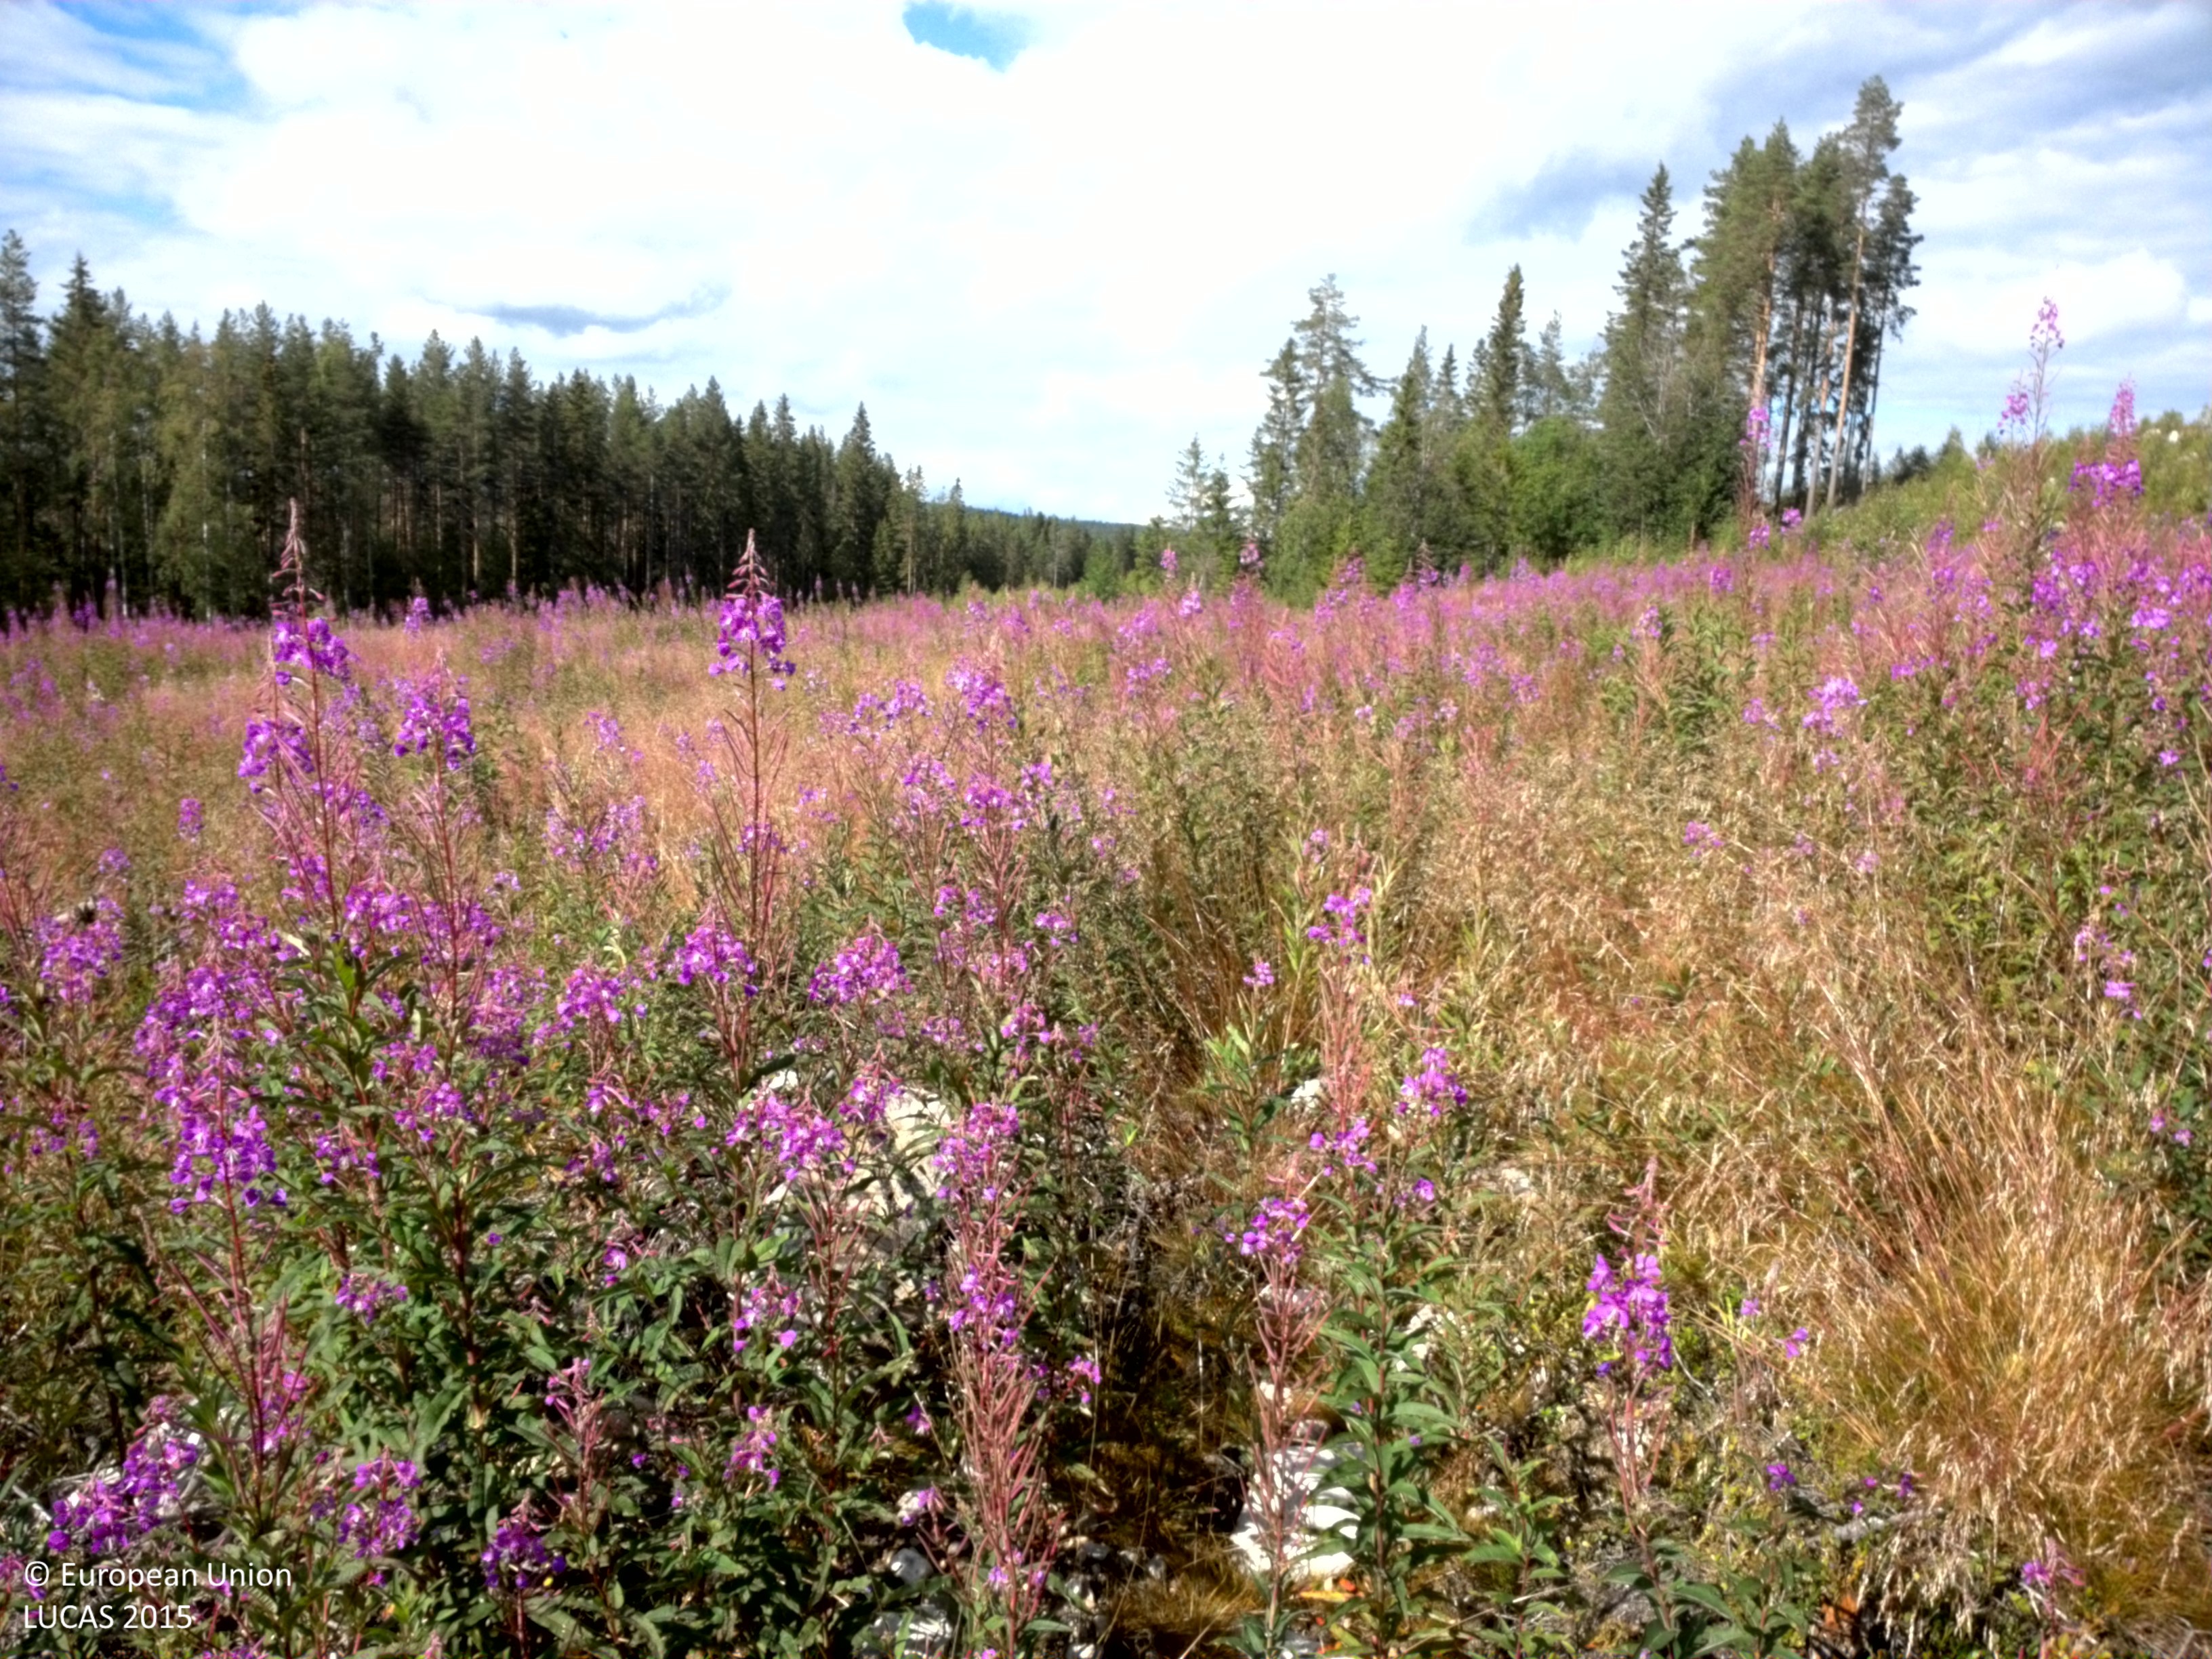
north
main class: Grassland
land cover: Grassland without tree/shrub cover
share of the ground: > 75 %
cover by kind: herbaceous plants 75 %, shrubs 5 %
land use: Forestry
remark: Clear cut
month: August
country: SE
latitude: 64.6469
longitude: 20.8413
